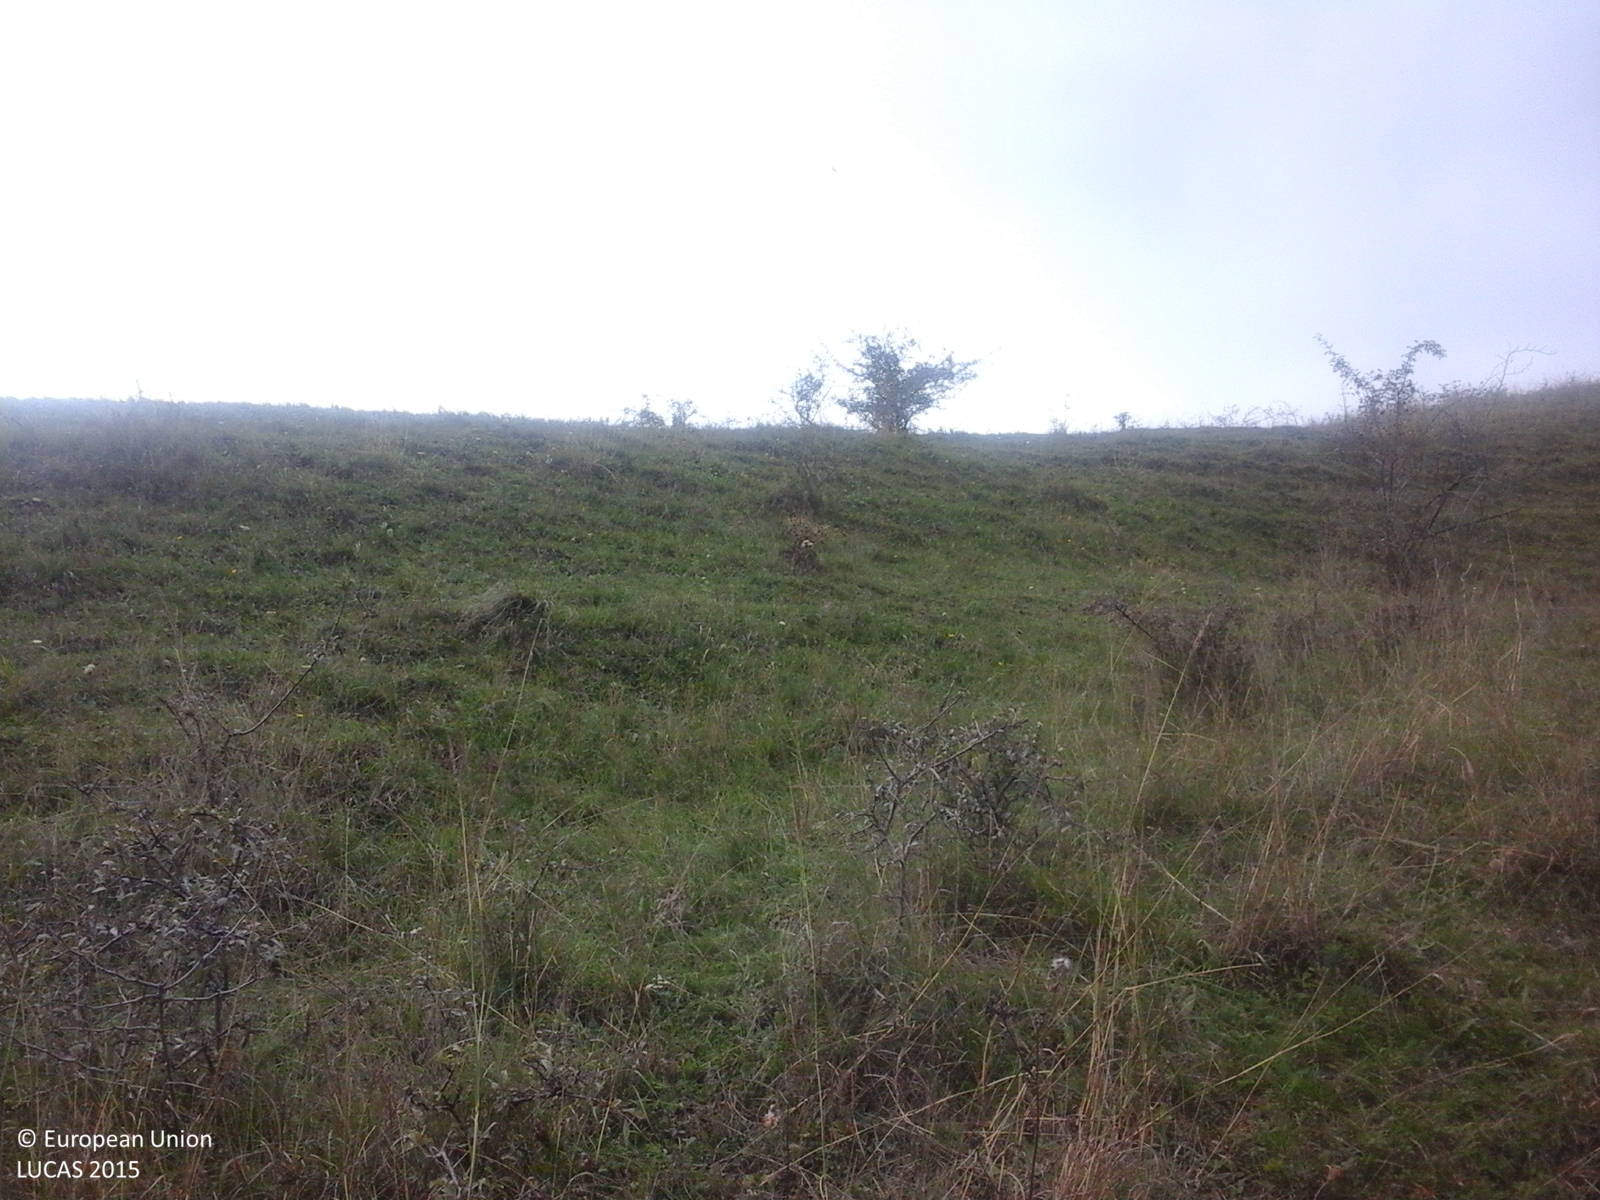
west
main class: Shrubland
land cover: Shrubland without tree cover
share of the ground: > 75 %
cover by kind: shrubs 100 %
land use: Semi-natural and natural areas not in use
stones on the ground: < 10 %
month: October
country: RO
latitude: 46.4422
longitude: 24.0440
